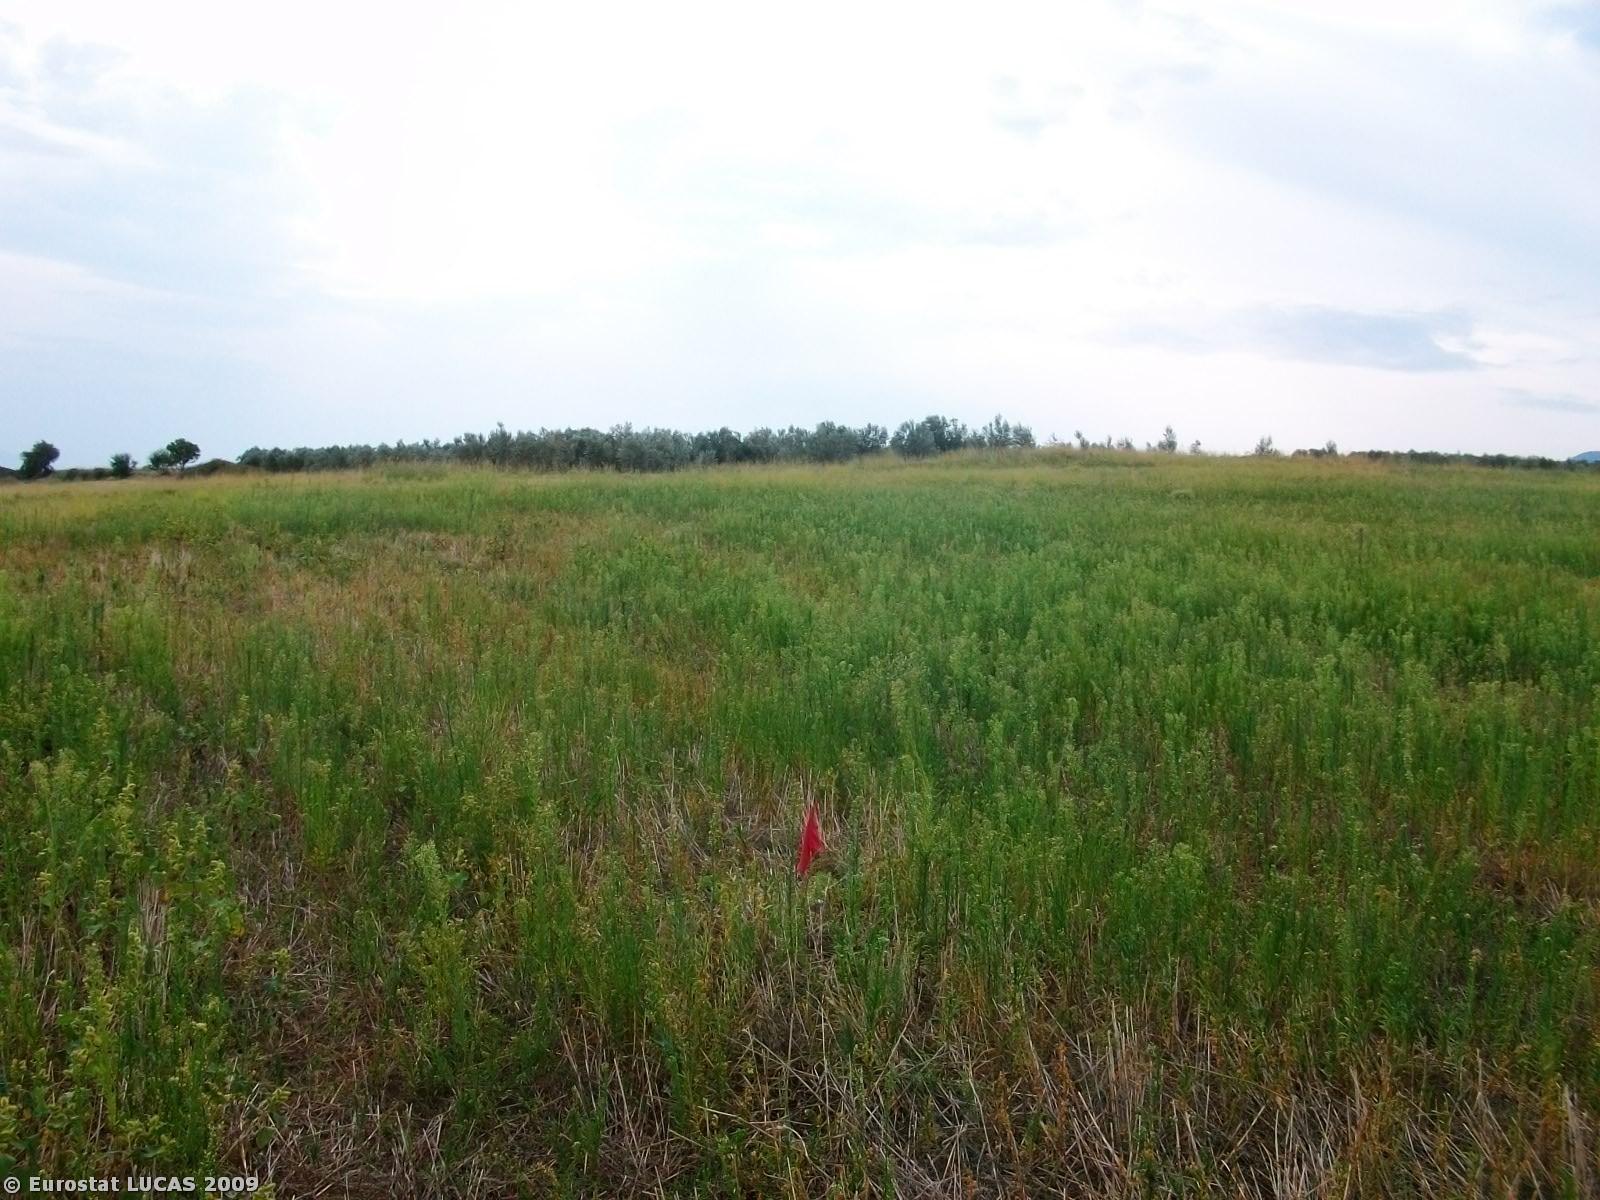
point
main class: Cropland
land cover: Durum wheat
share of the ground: 50 - 75 %
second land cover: Spontaneously vegetated surfaces
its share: 50 - 75 %
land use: Agriculture (excluding fallow land and kitchen gardens)
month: September
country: GR
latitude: 40.8892
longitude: 23.6081
